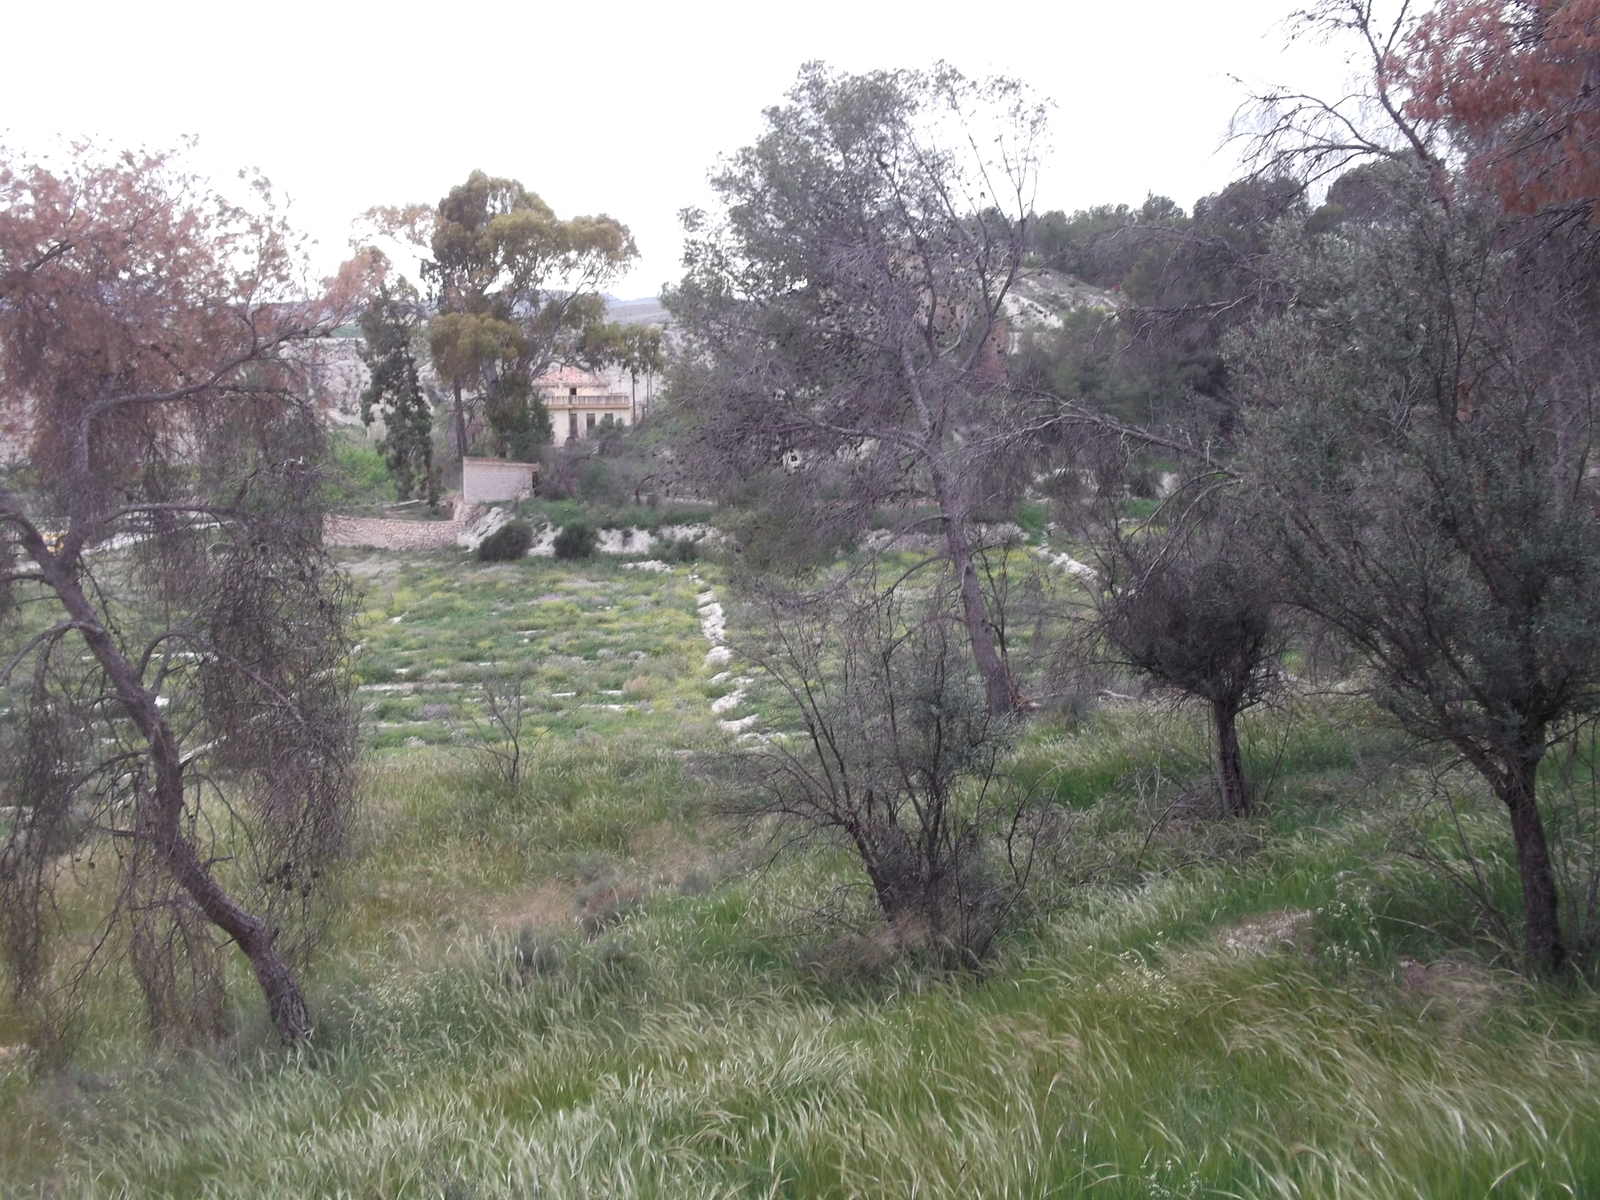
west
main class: Woodland
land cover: Pine dominated mixed woodland
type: coniferous forest of the mediterranean region
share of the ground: 25 - 50 %
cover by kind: consolidated bare surface 50 %, coniferous forest trees 25 %, broadleaved forest trees 25 %
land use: Semi-natural and natural areas not in use
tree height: > 5 m
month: April
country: ES
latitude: 38.0304
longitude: -1.3897
